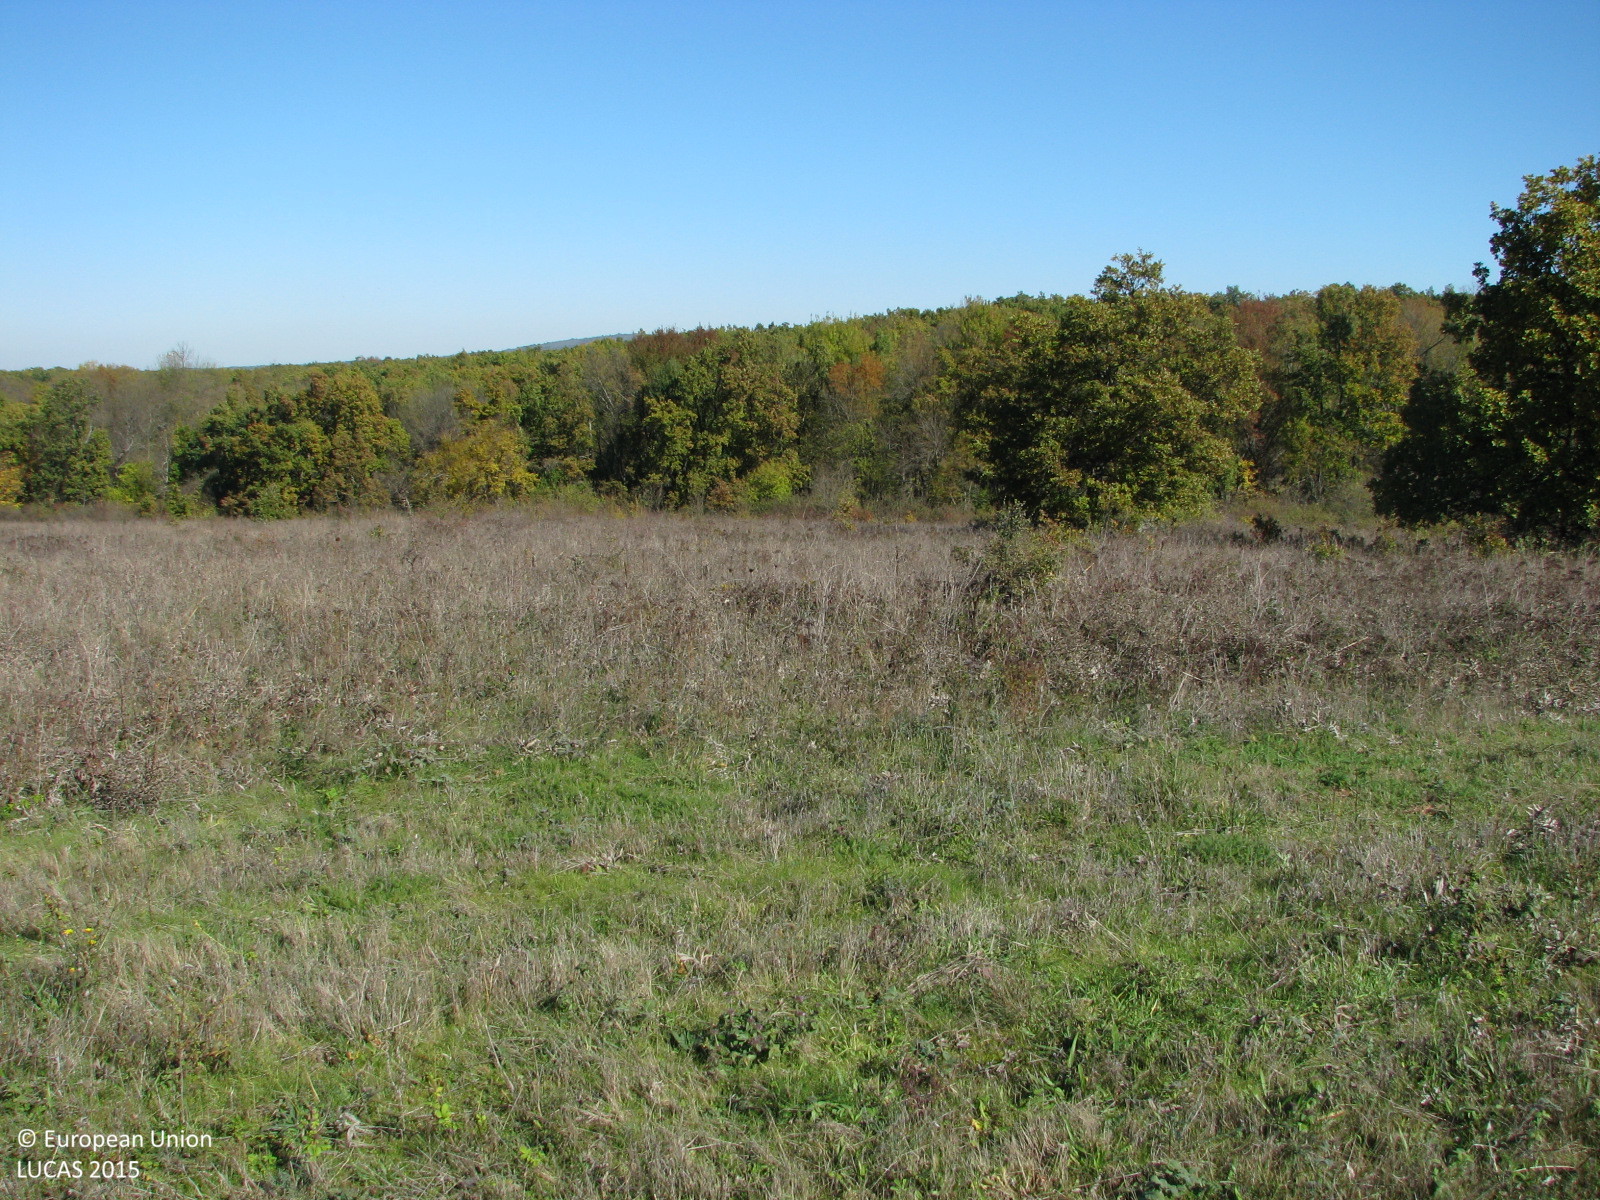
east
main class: Grassland
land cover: Grassland without tree/shrub cover
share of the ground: > 75 %
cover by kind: herbaceous plants 100 %
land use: Agriculture (excluding fallow land and kitchen gardens)
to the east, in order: Grassland without tree/shrub cover; Broadleaved woodland; Grassland without tree/shrub cover; Tracks; Grassland without tree/shrub cover; Broadleaved woodland; Grassland without tree/shrub cover; Broadleaved woodland
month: November
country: BG
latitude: 42.0252
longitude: 26.7221
